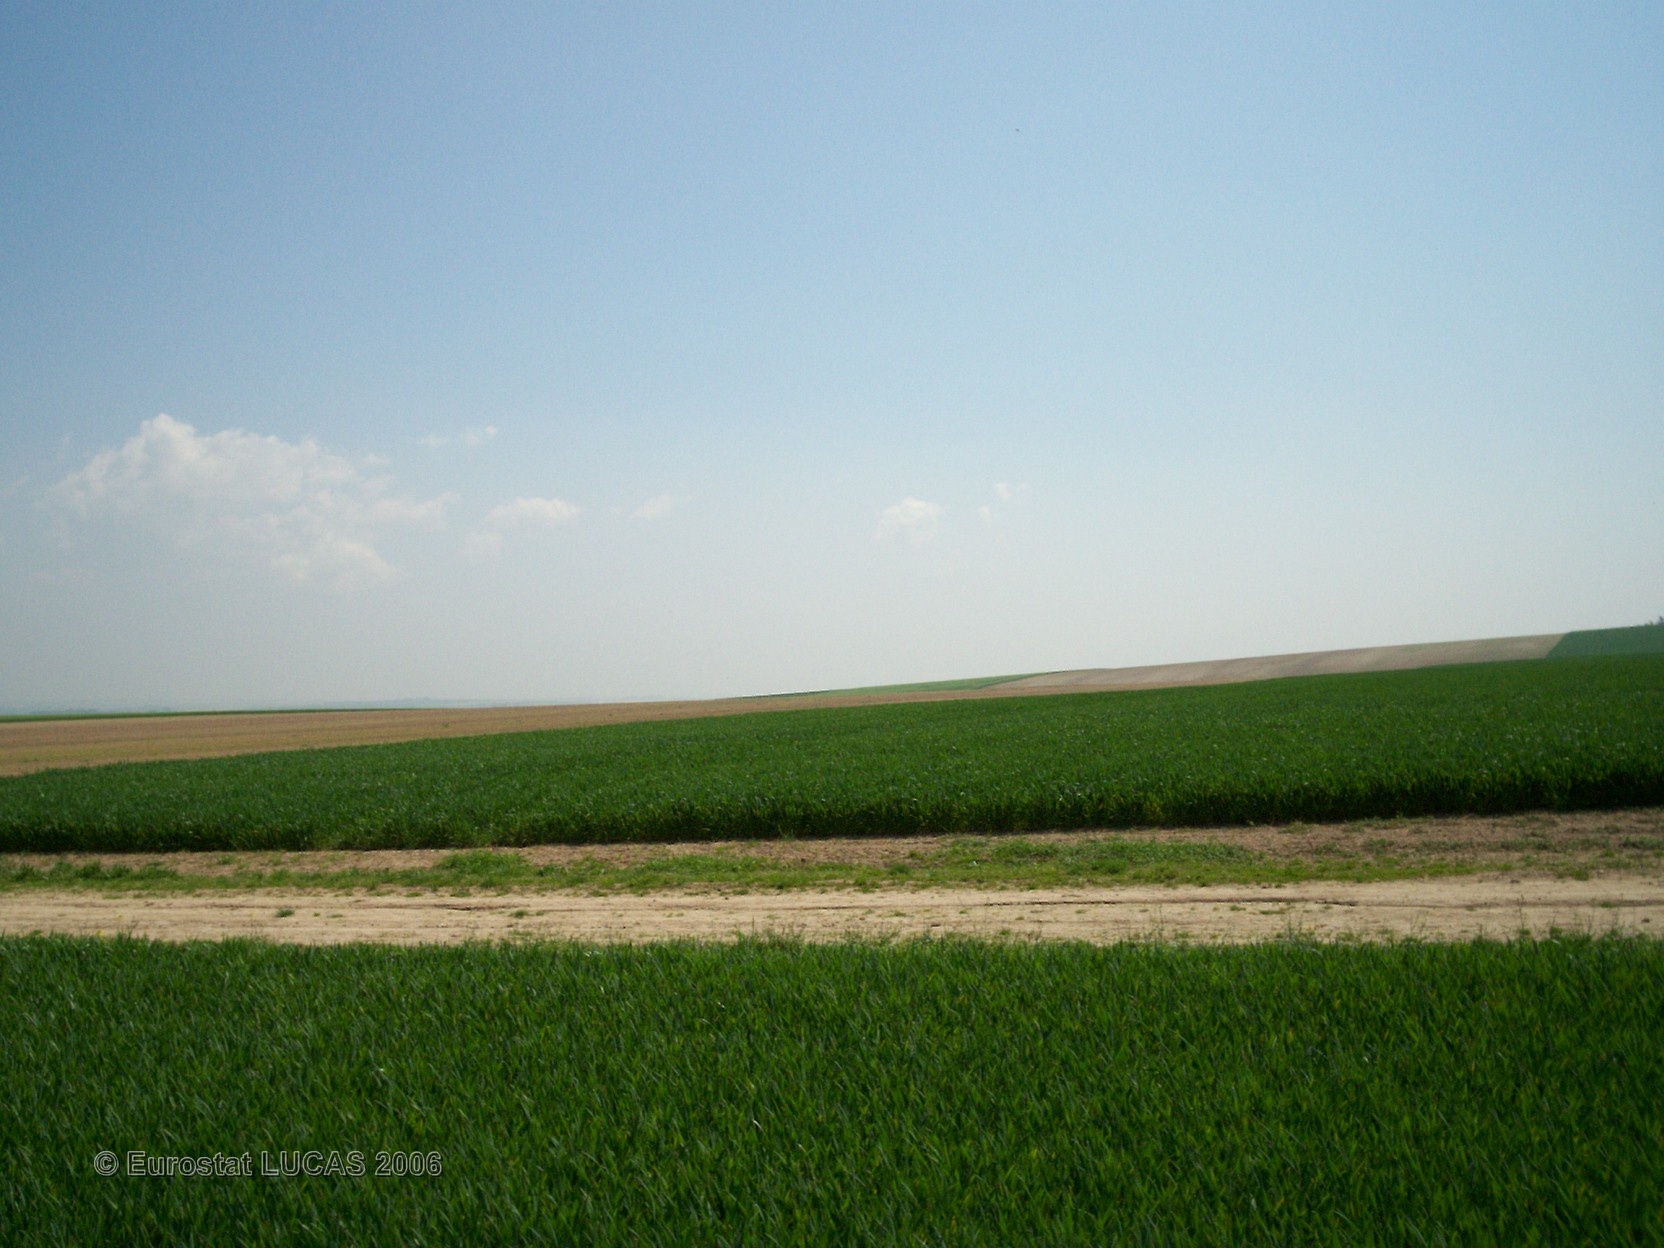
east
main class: Cropland
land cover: Common wheat
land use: Agriculture (excluding fallow land and kitchen gardens)
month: May
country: FR
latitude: 49.2509
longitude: 4.3496
